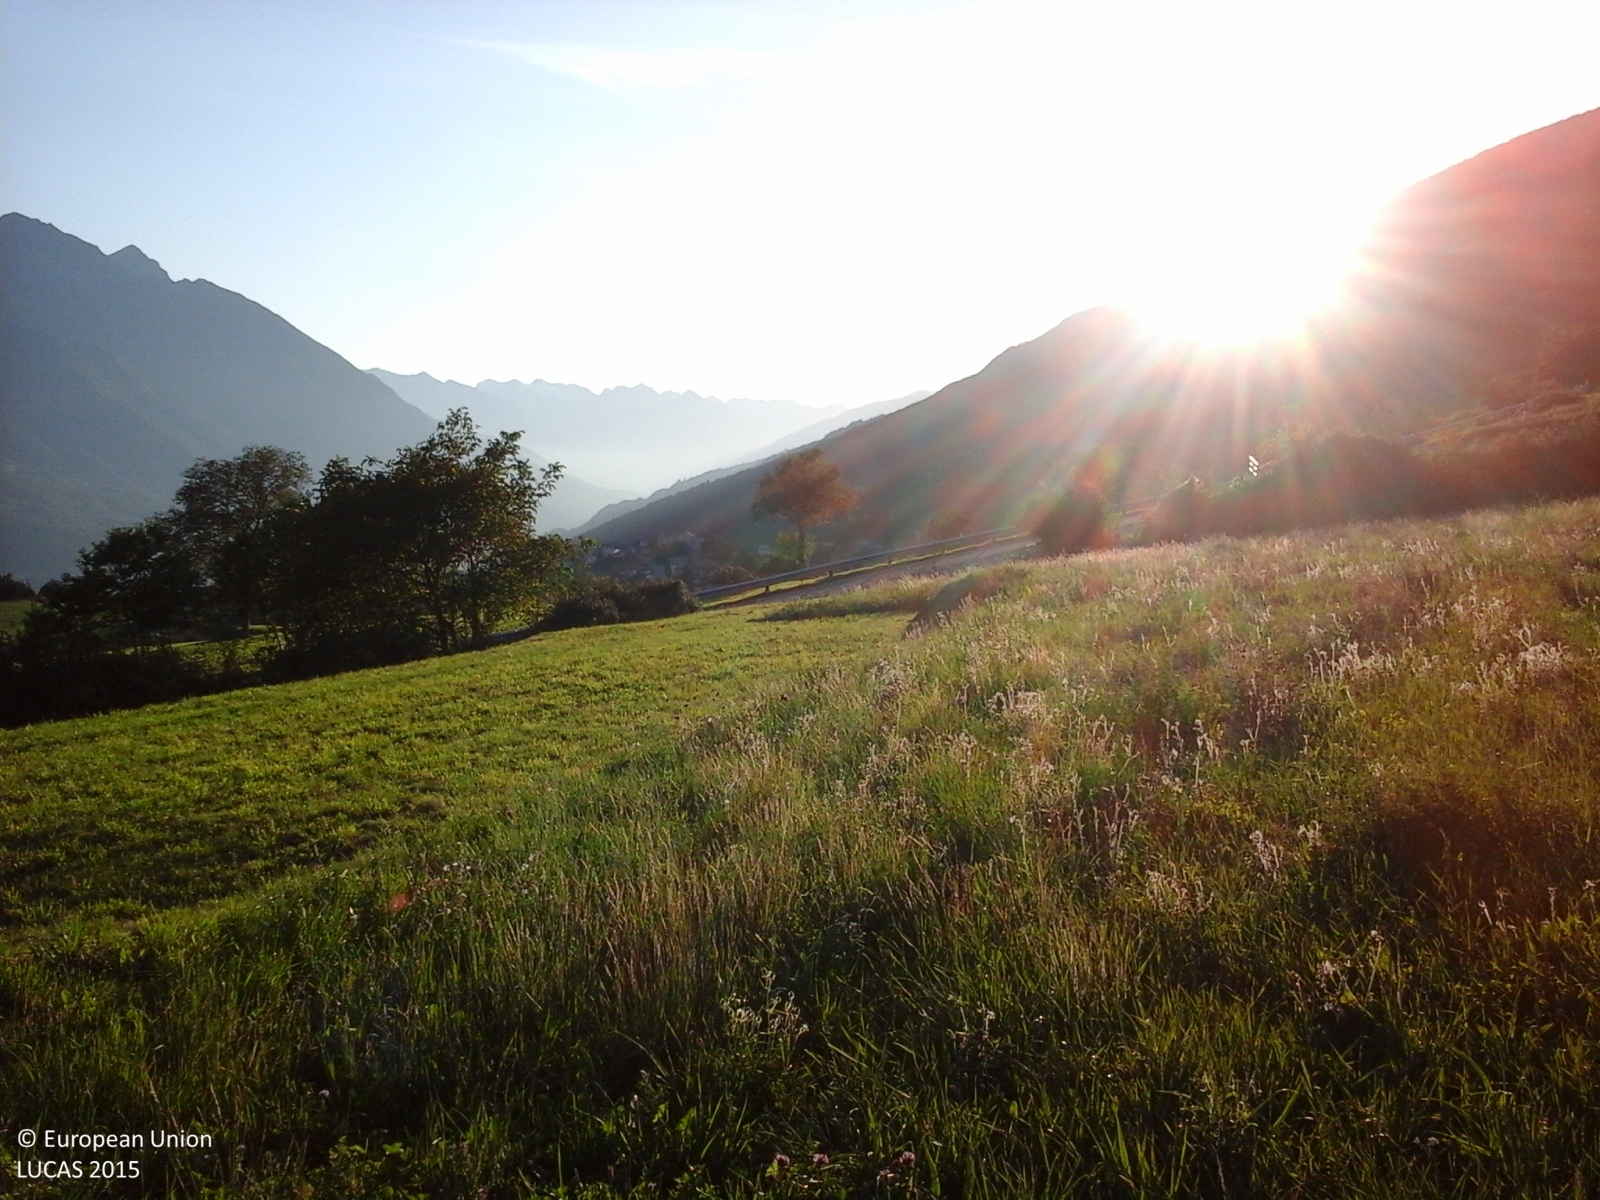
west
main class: Grassland
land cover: Grassland without tree/shrub cover
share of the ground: > 75 %
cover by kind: herbaceous plants 95 %, shrubs 5 %
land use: Agriculture (excluding fallow land and kitchen gardens)
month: August
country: IT
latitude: 45.7644
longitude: 7.5476
